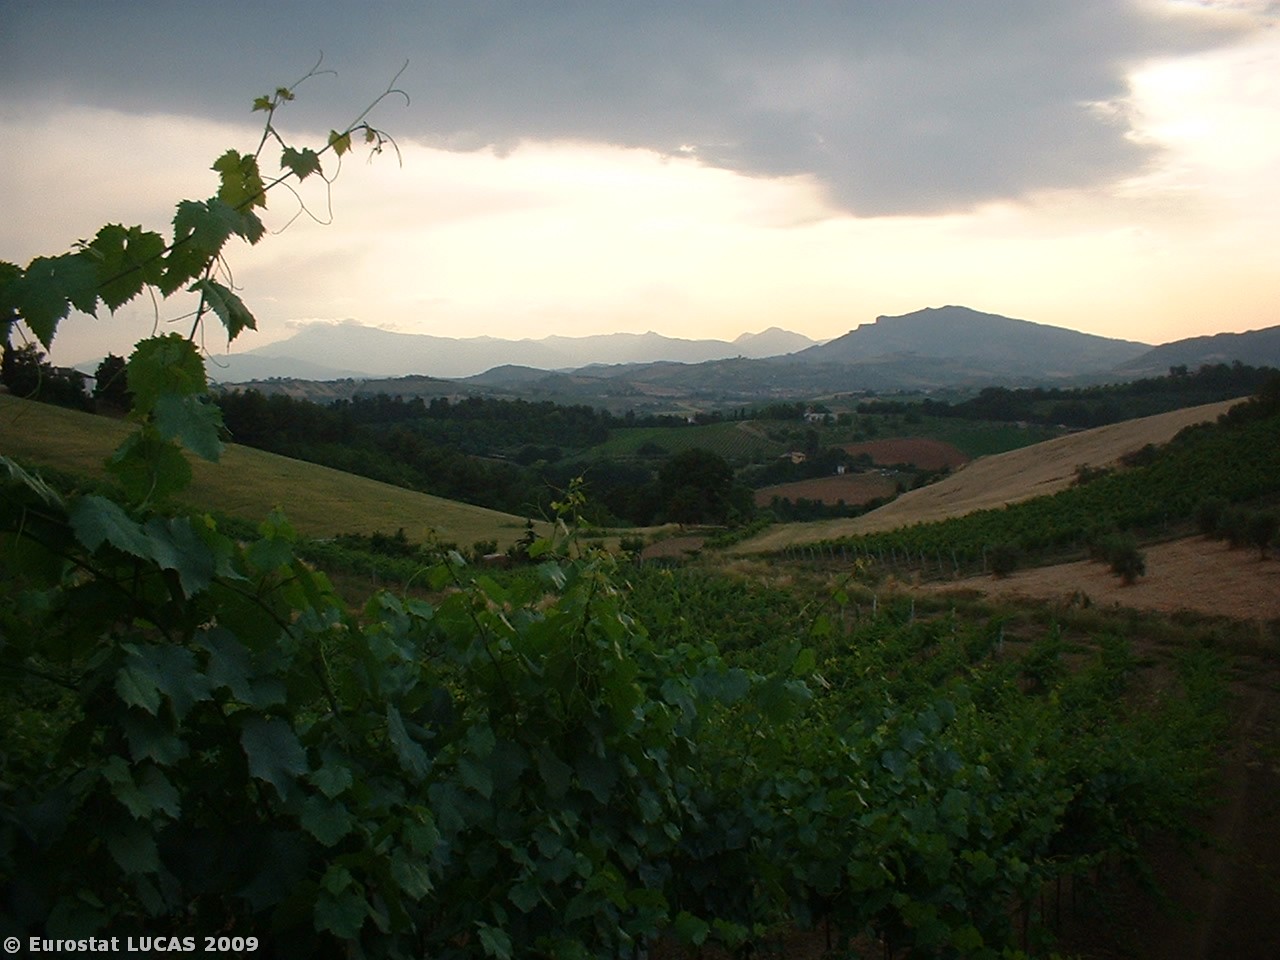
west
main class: Cropland
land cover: Vineyards
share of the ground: 25 - 50 %
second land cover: Bare land
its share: > 75 %
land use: Agriculture (excluding fallow land and kitchen gardens)
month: June
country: IT
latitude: 42.8928
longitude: 13.7246
